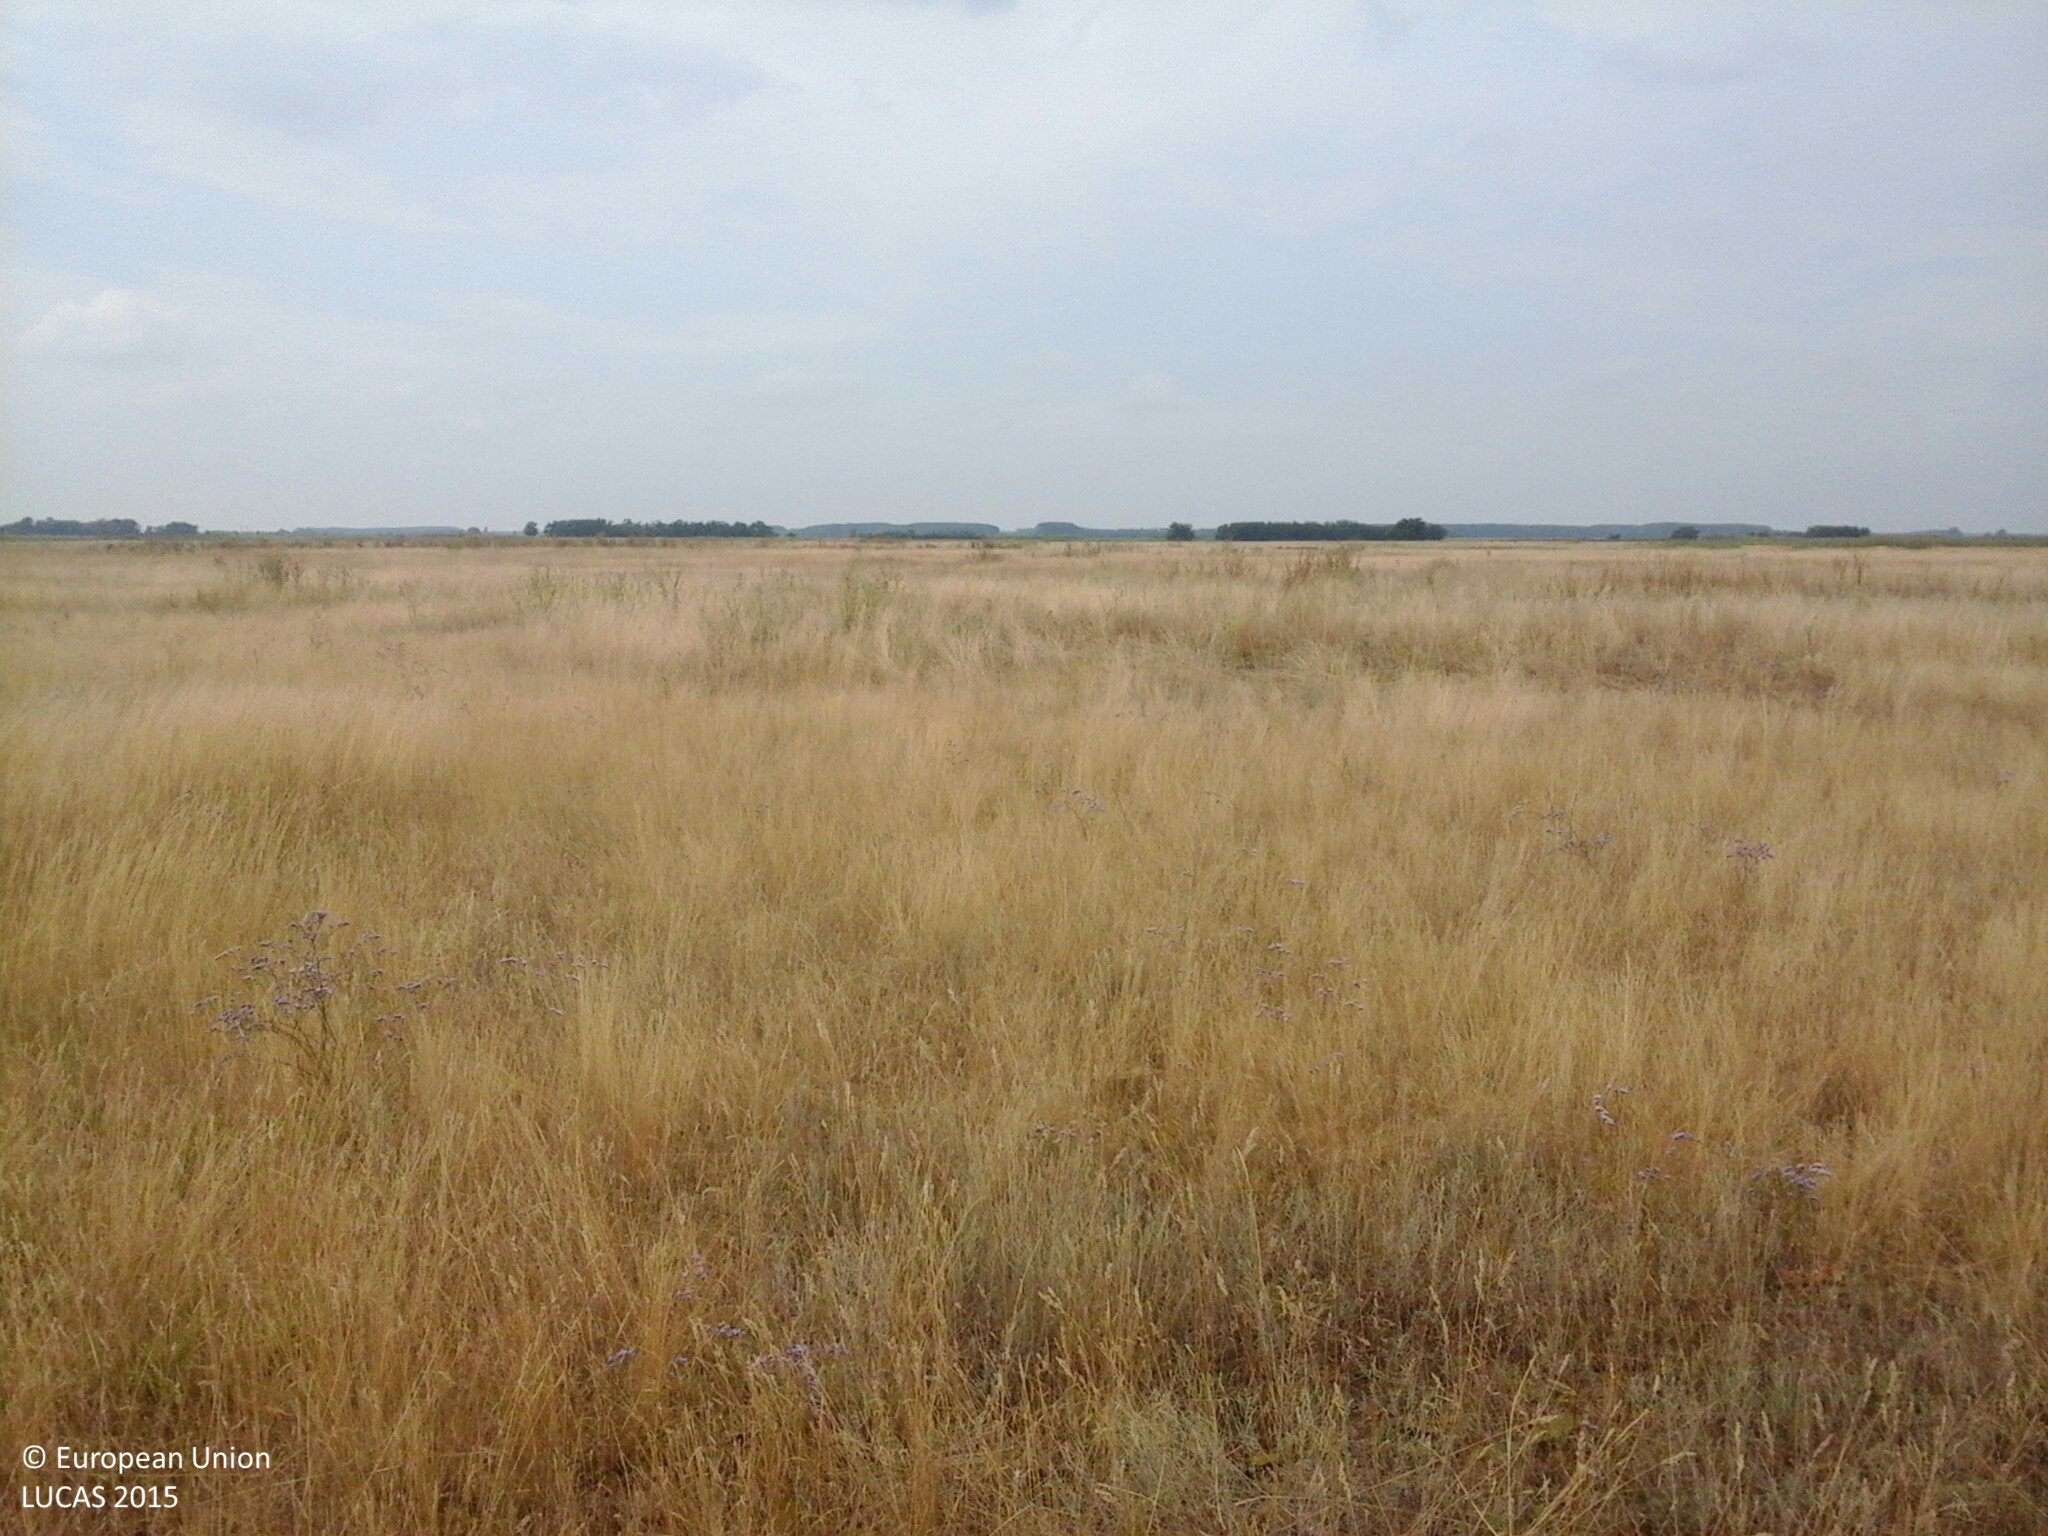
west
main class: Grassland
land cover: Grassland without tree/shrub cover
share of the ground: > 75 %
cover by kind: herbaceous plants 100 %
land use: Semi-natural and natural areas not in use
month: August
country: HU
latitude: 47.0553
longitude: 21.5072
